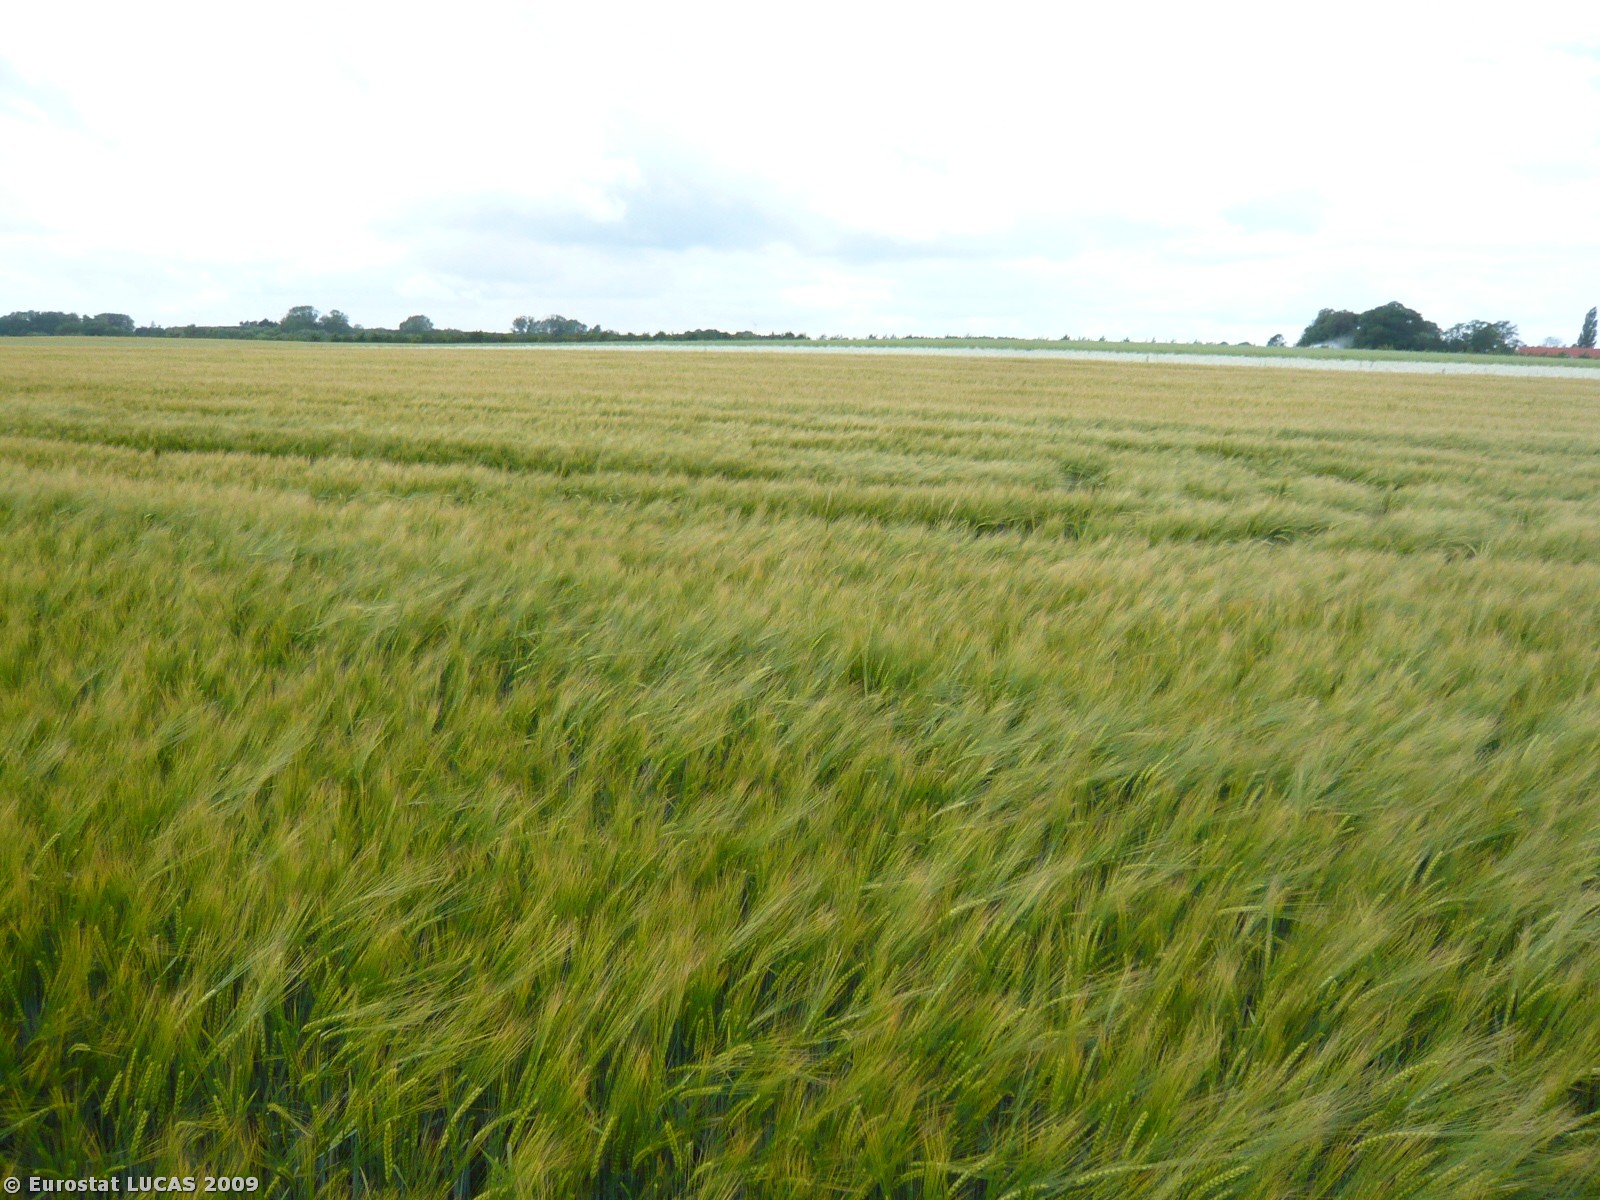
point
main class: Cropland
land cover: Barley
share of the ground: > 75 %
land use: Agriculture (excluding fallow land and kitchen gardens)
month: July
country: DK
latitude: 55.3904
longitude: 11.2776
